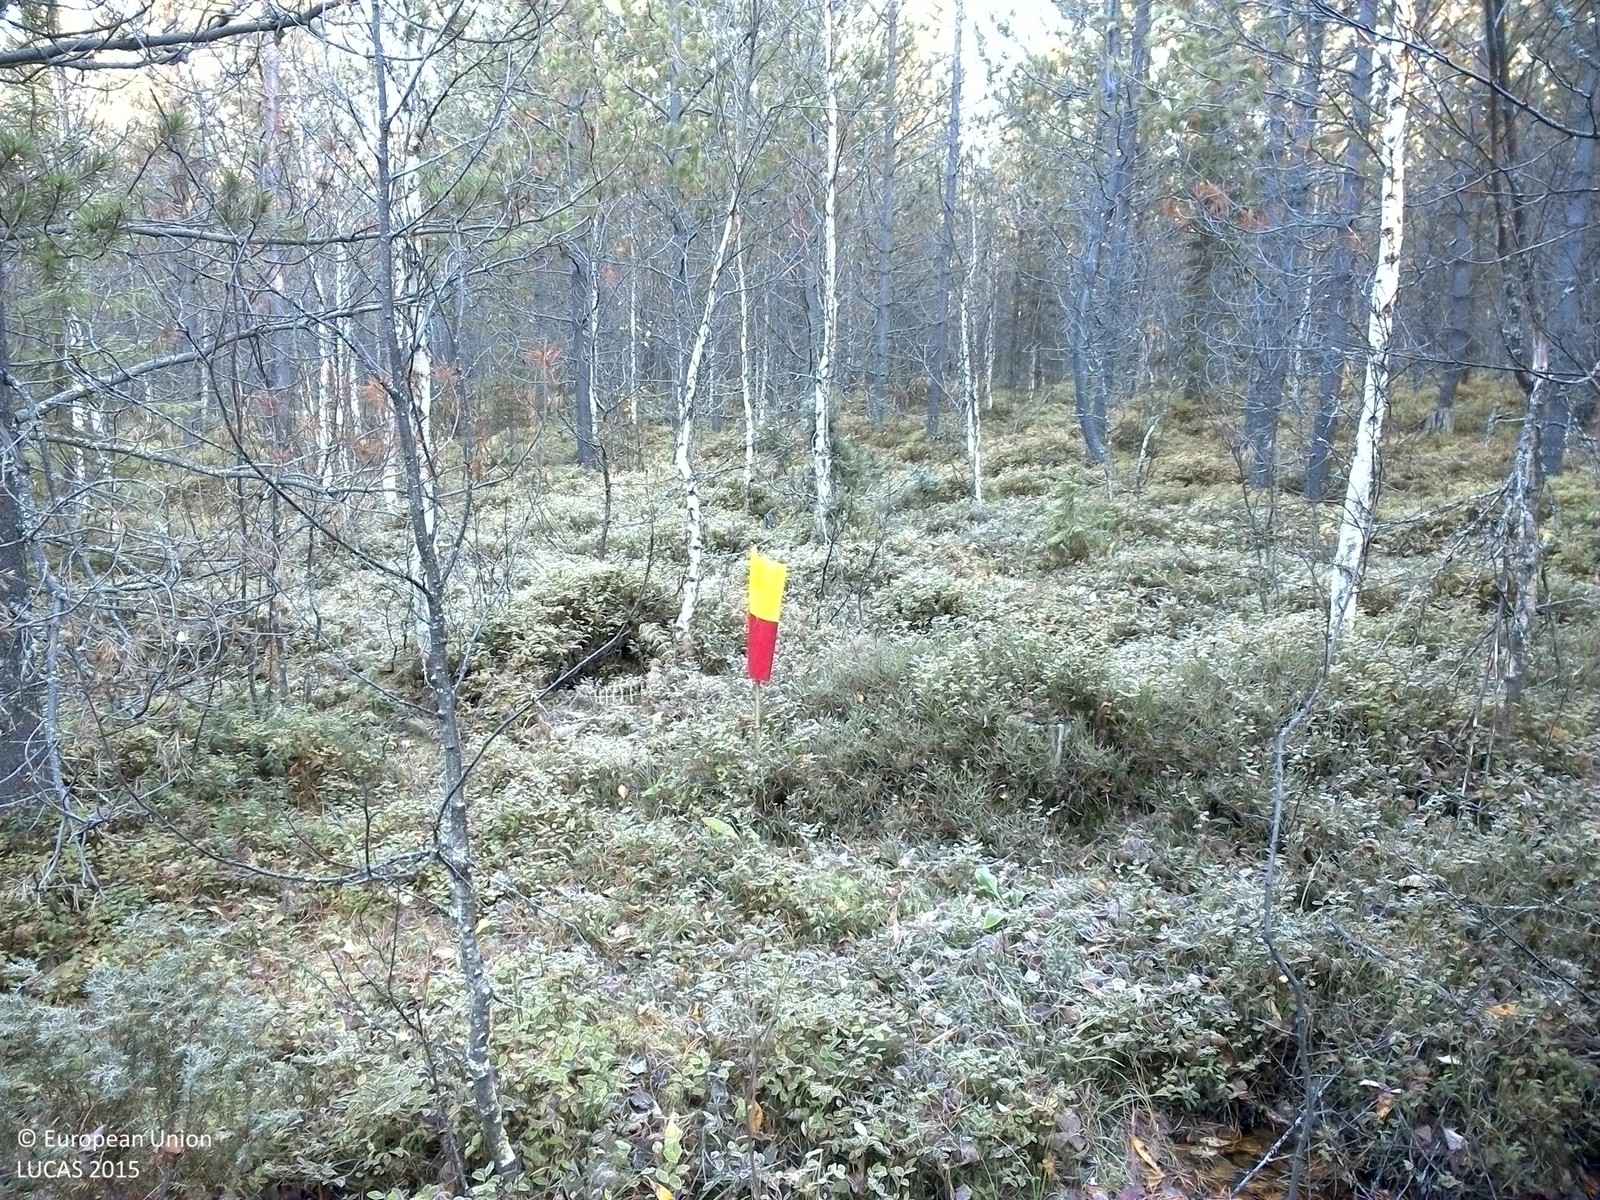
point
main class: Woodland
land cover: Pine dominated mixed woodland
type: exotic forest
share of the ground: 50 - 75 %
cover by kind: coniferous forest trees 40 %, shrubs 35 %, broadleaved forest trees 15 %, lichens and mosses 10 %
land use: Forestry
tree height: > 5 m
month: October
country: SE
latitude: 64.5549
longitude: 15.5394
